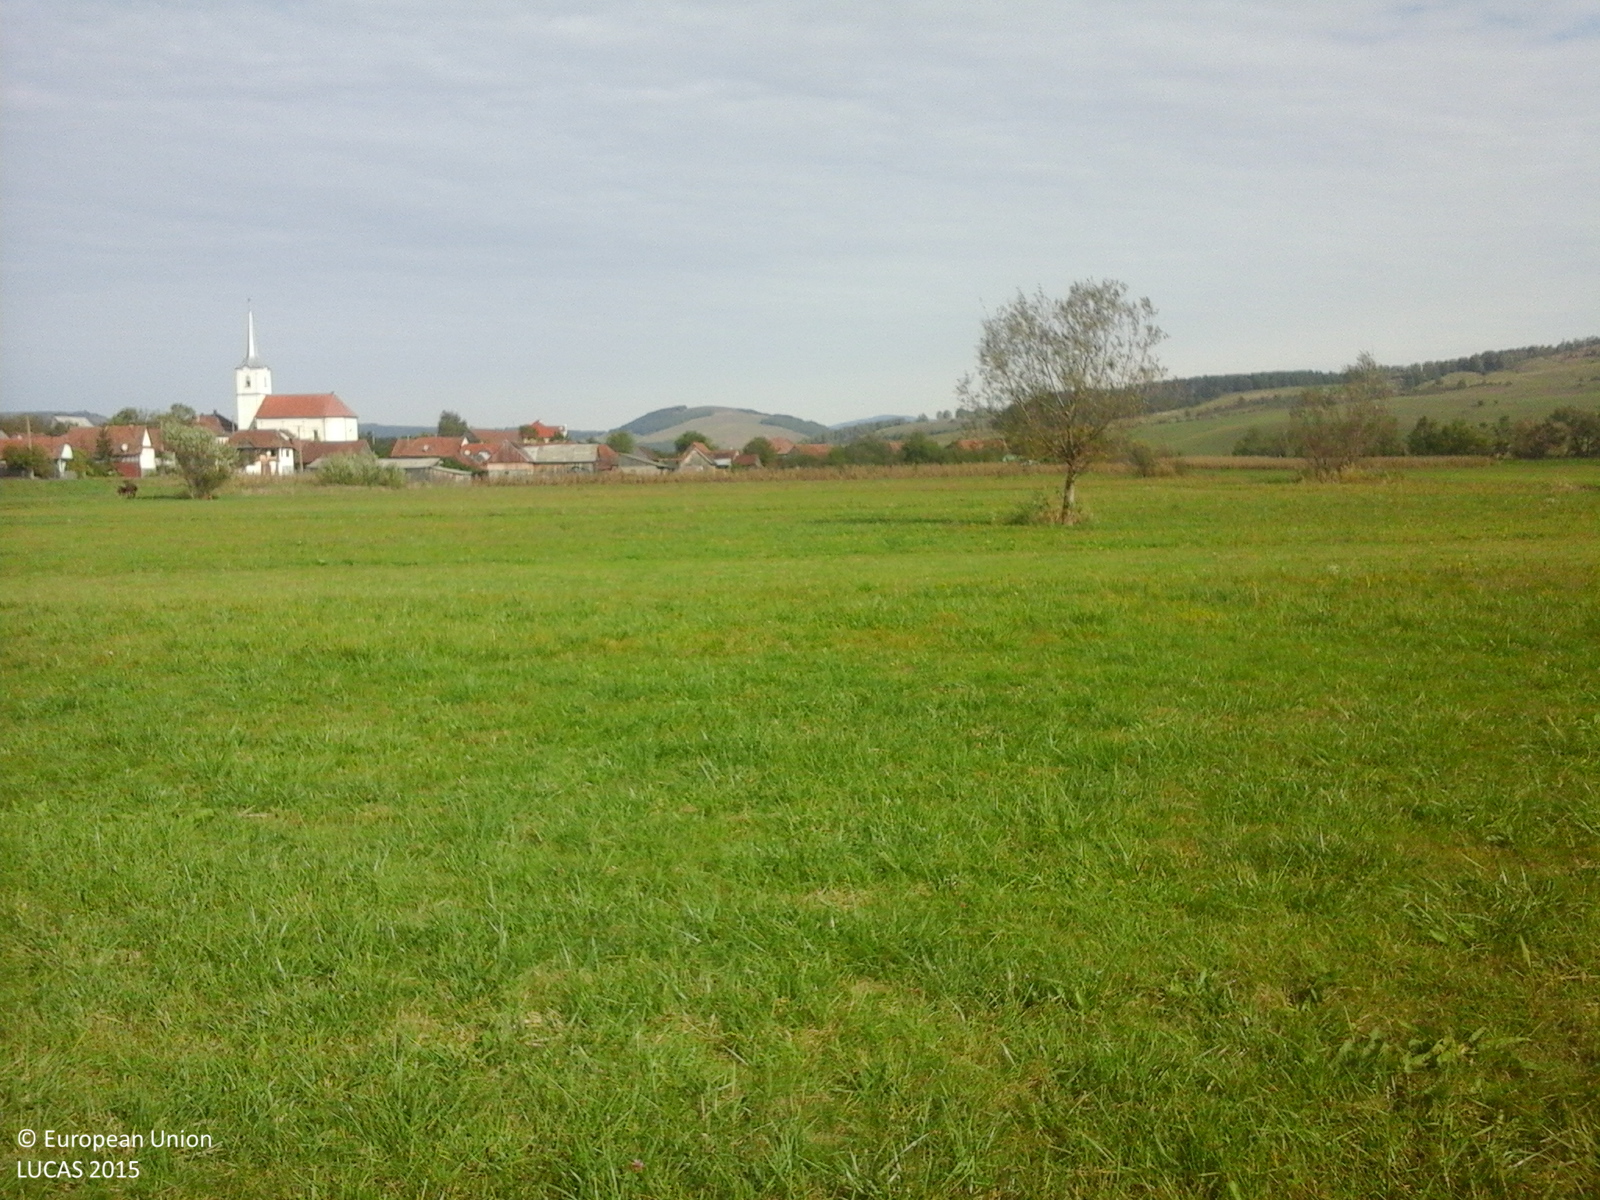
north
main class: Grassland
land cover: Grassland without tree/shrub cover
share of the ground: > 75 %
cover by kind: herbaceous plants 100 %
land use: Agriculture (excluding fallow land and kitchen gardens)
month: October
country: RO
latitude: 46.2011
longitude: 25.3830
